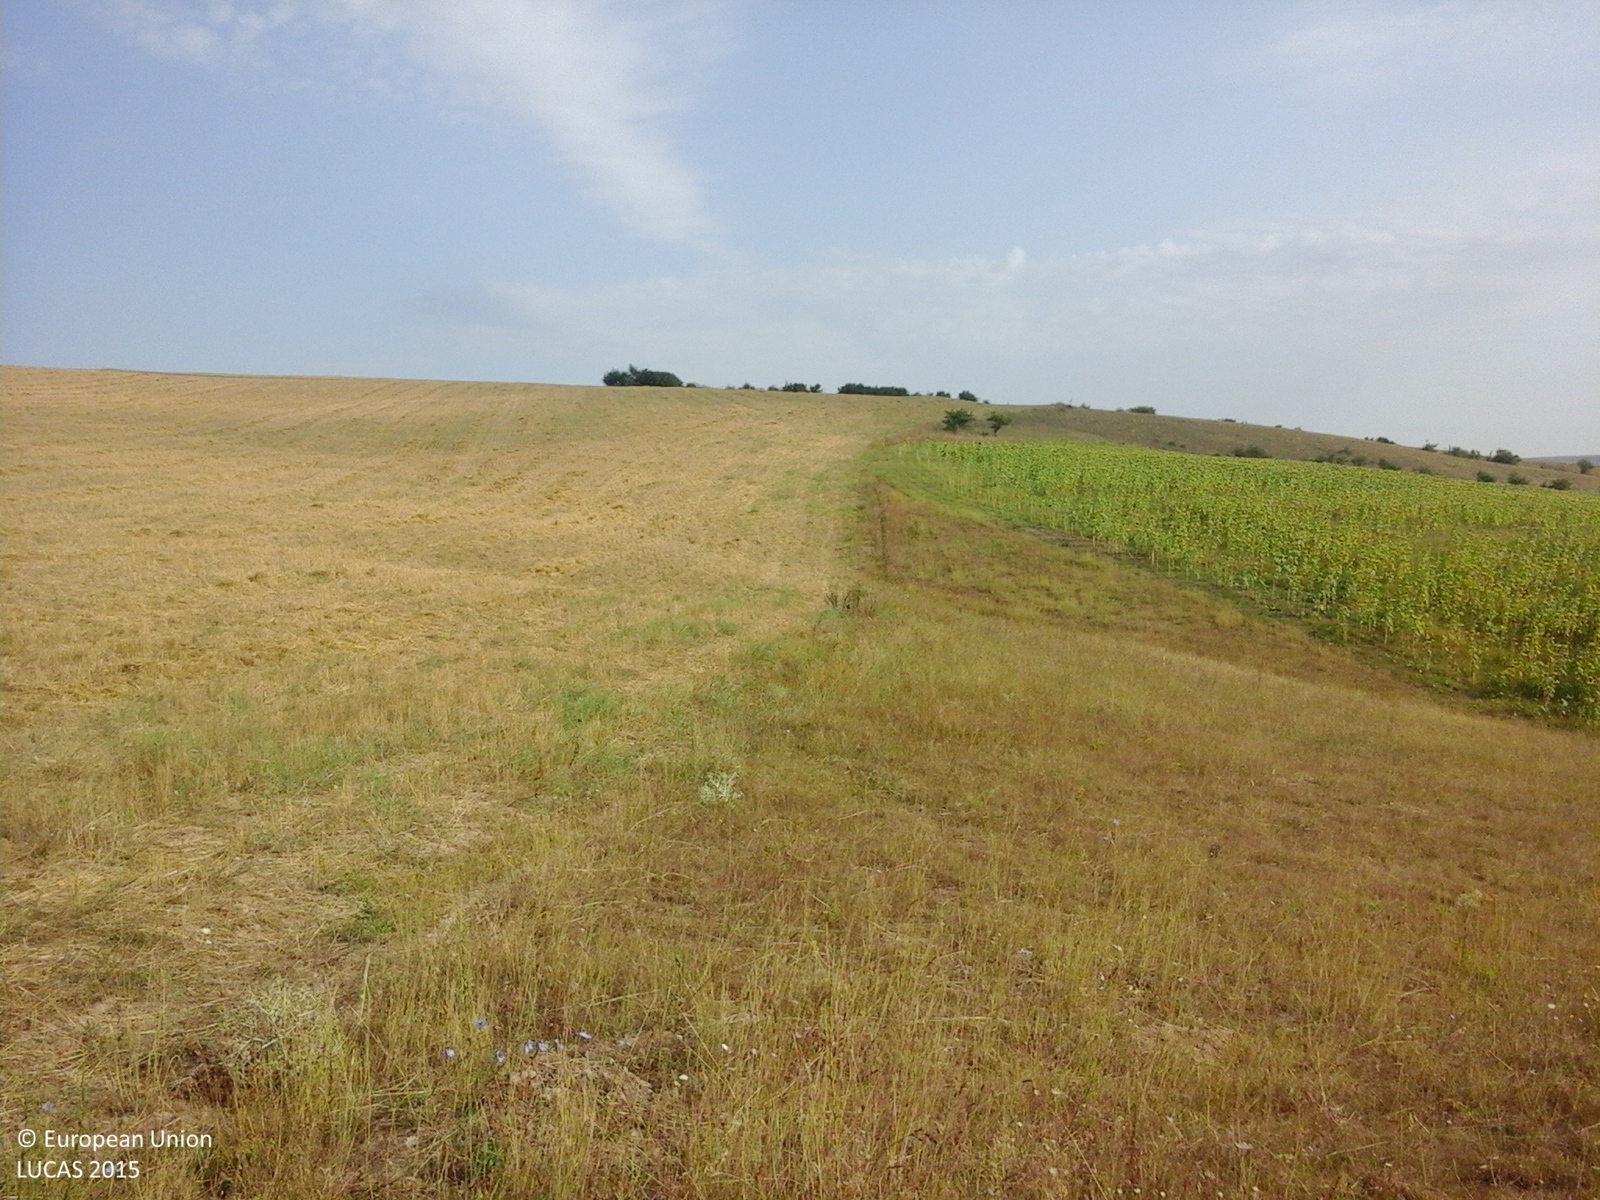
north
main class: Grassland
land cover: Grassland without tree/shrub cover
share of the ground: > 75 %
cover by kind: herbaceous plants 100 %
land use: Agriculture (excluding fallow land and kitchen gardens)
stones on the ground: < 10 %
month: August
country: RO
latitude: 44.0839
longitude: 27.9217
